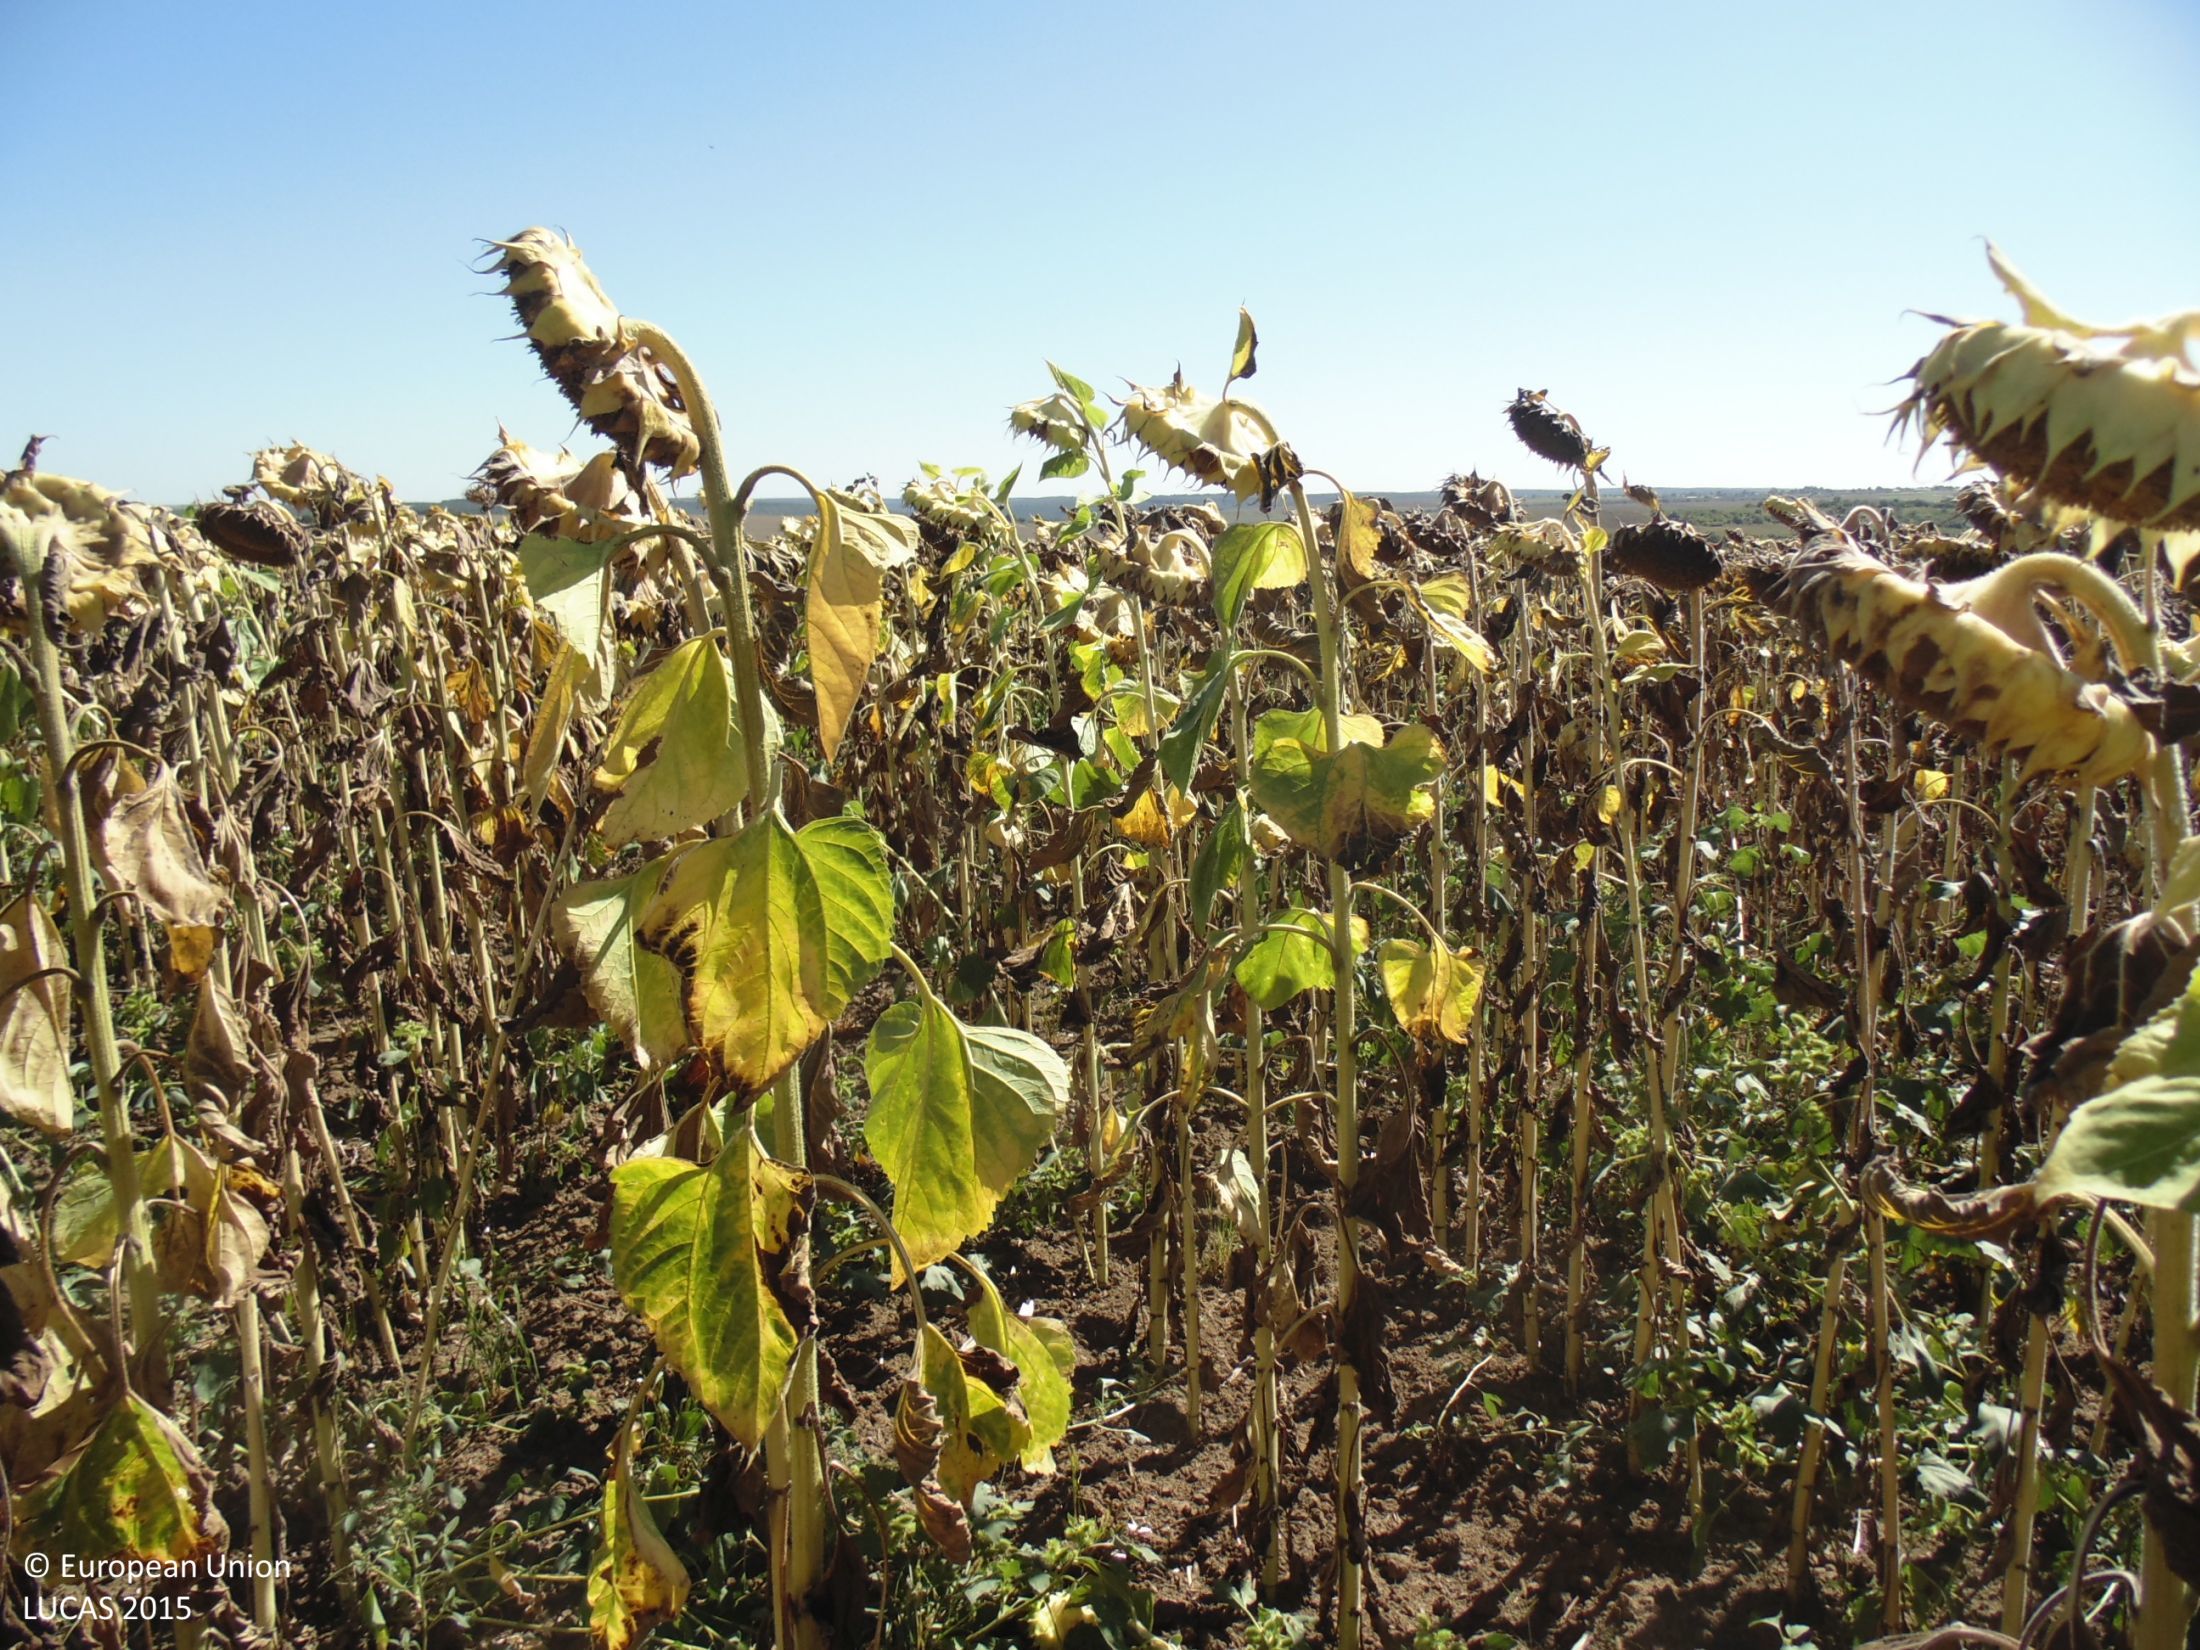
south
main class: Cropland
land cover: Sunflower
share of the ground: > 75 %
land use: Agriculture (excluding fallow land and kitchen gardens)
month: September
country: BG
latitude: 43.8837
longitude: 27.2682
